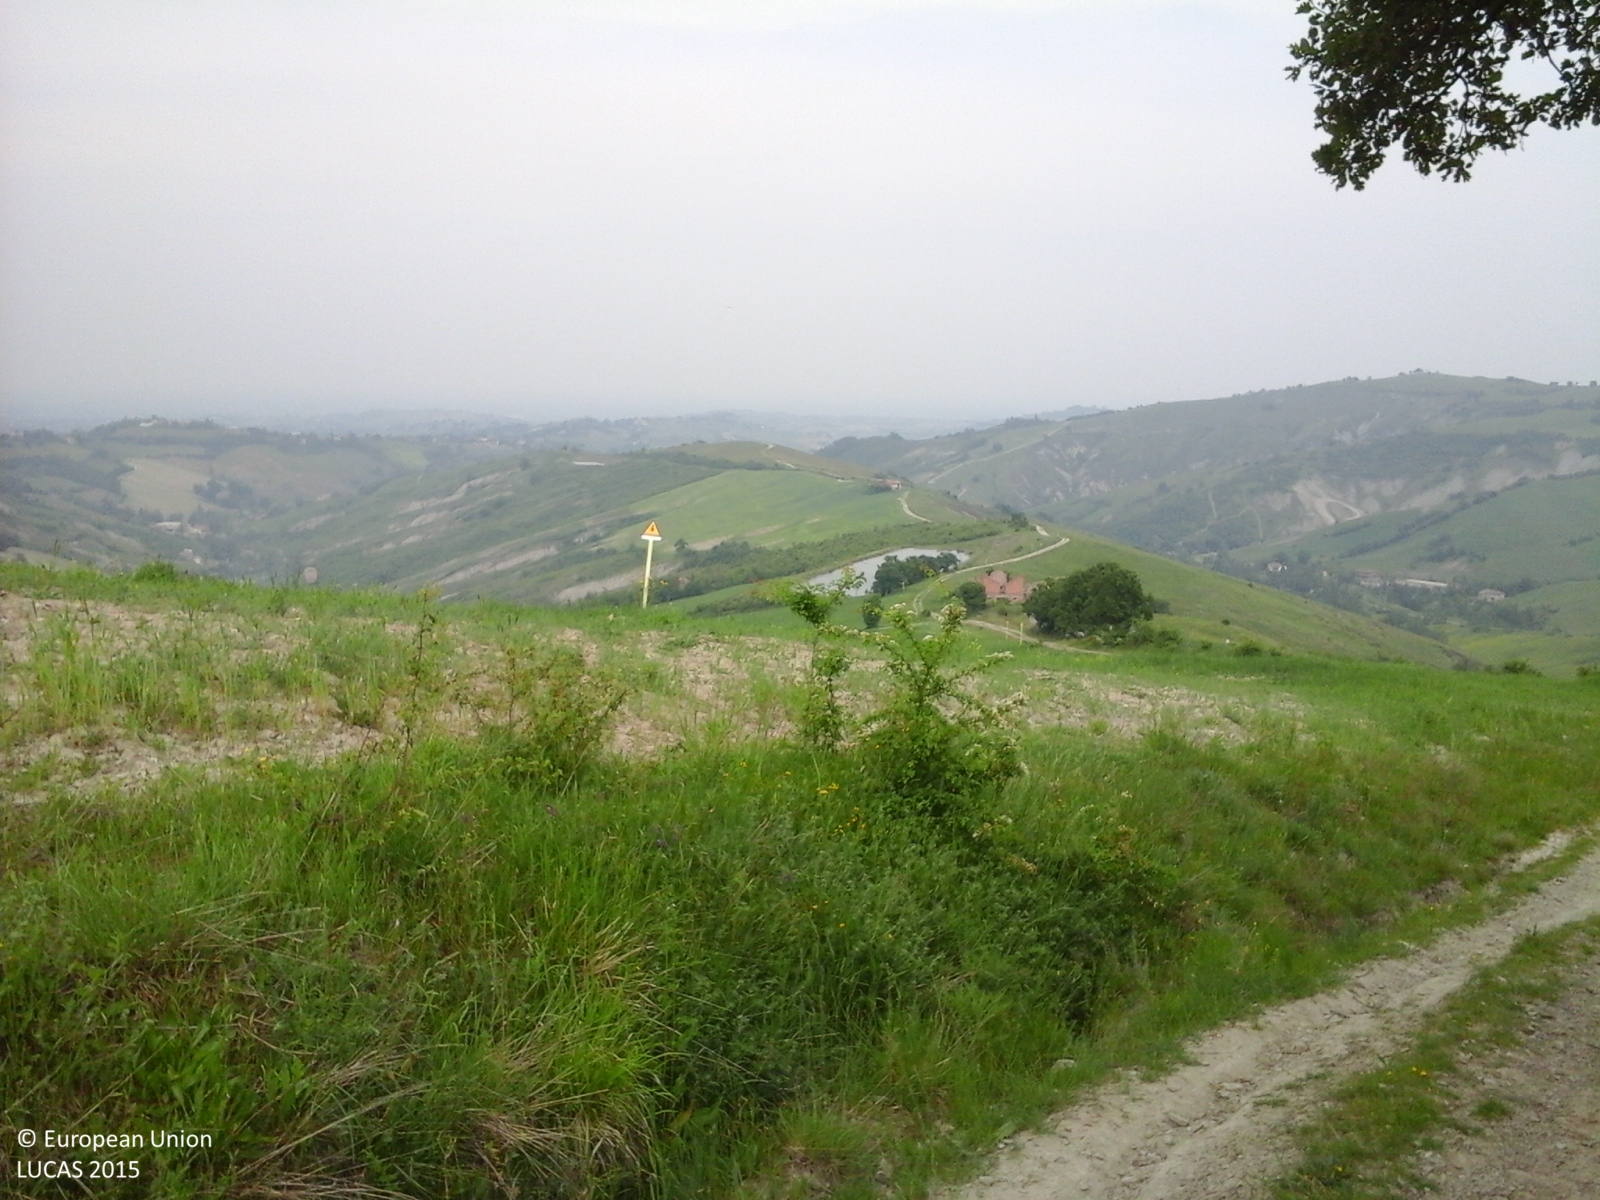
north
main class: Woodland
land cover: Broadleaved woodland
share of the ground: 50 - 75 %
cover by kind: broadleaved forest trees 60 %, herbaceous plants 30 %, shrubs 10 %
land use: Amenities, museums, leisure
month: May
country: IT
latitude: 44.4549
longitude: 10.8903
